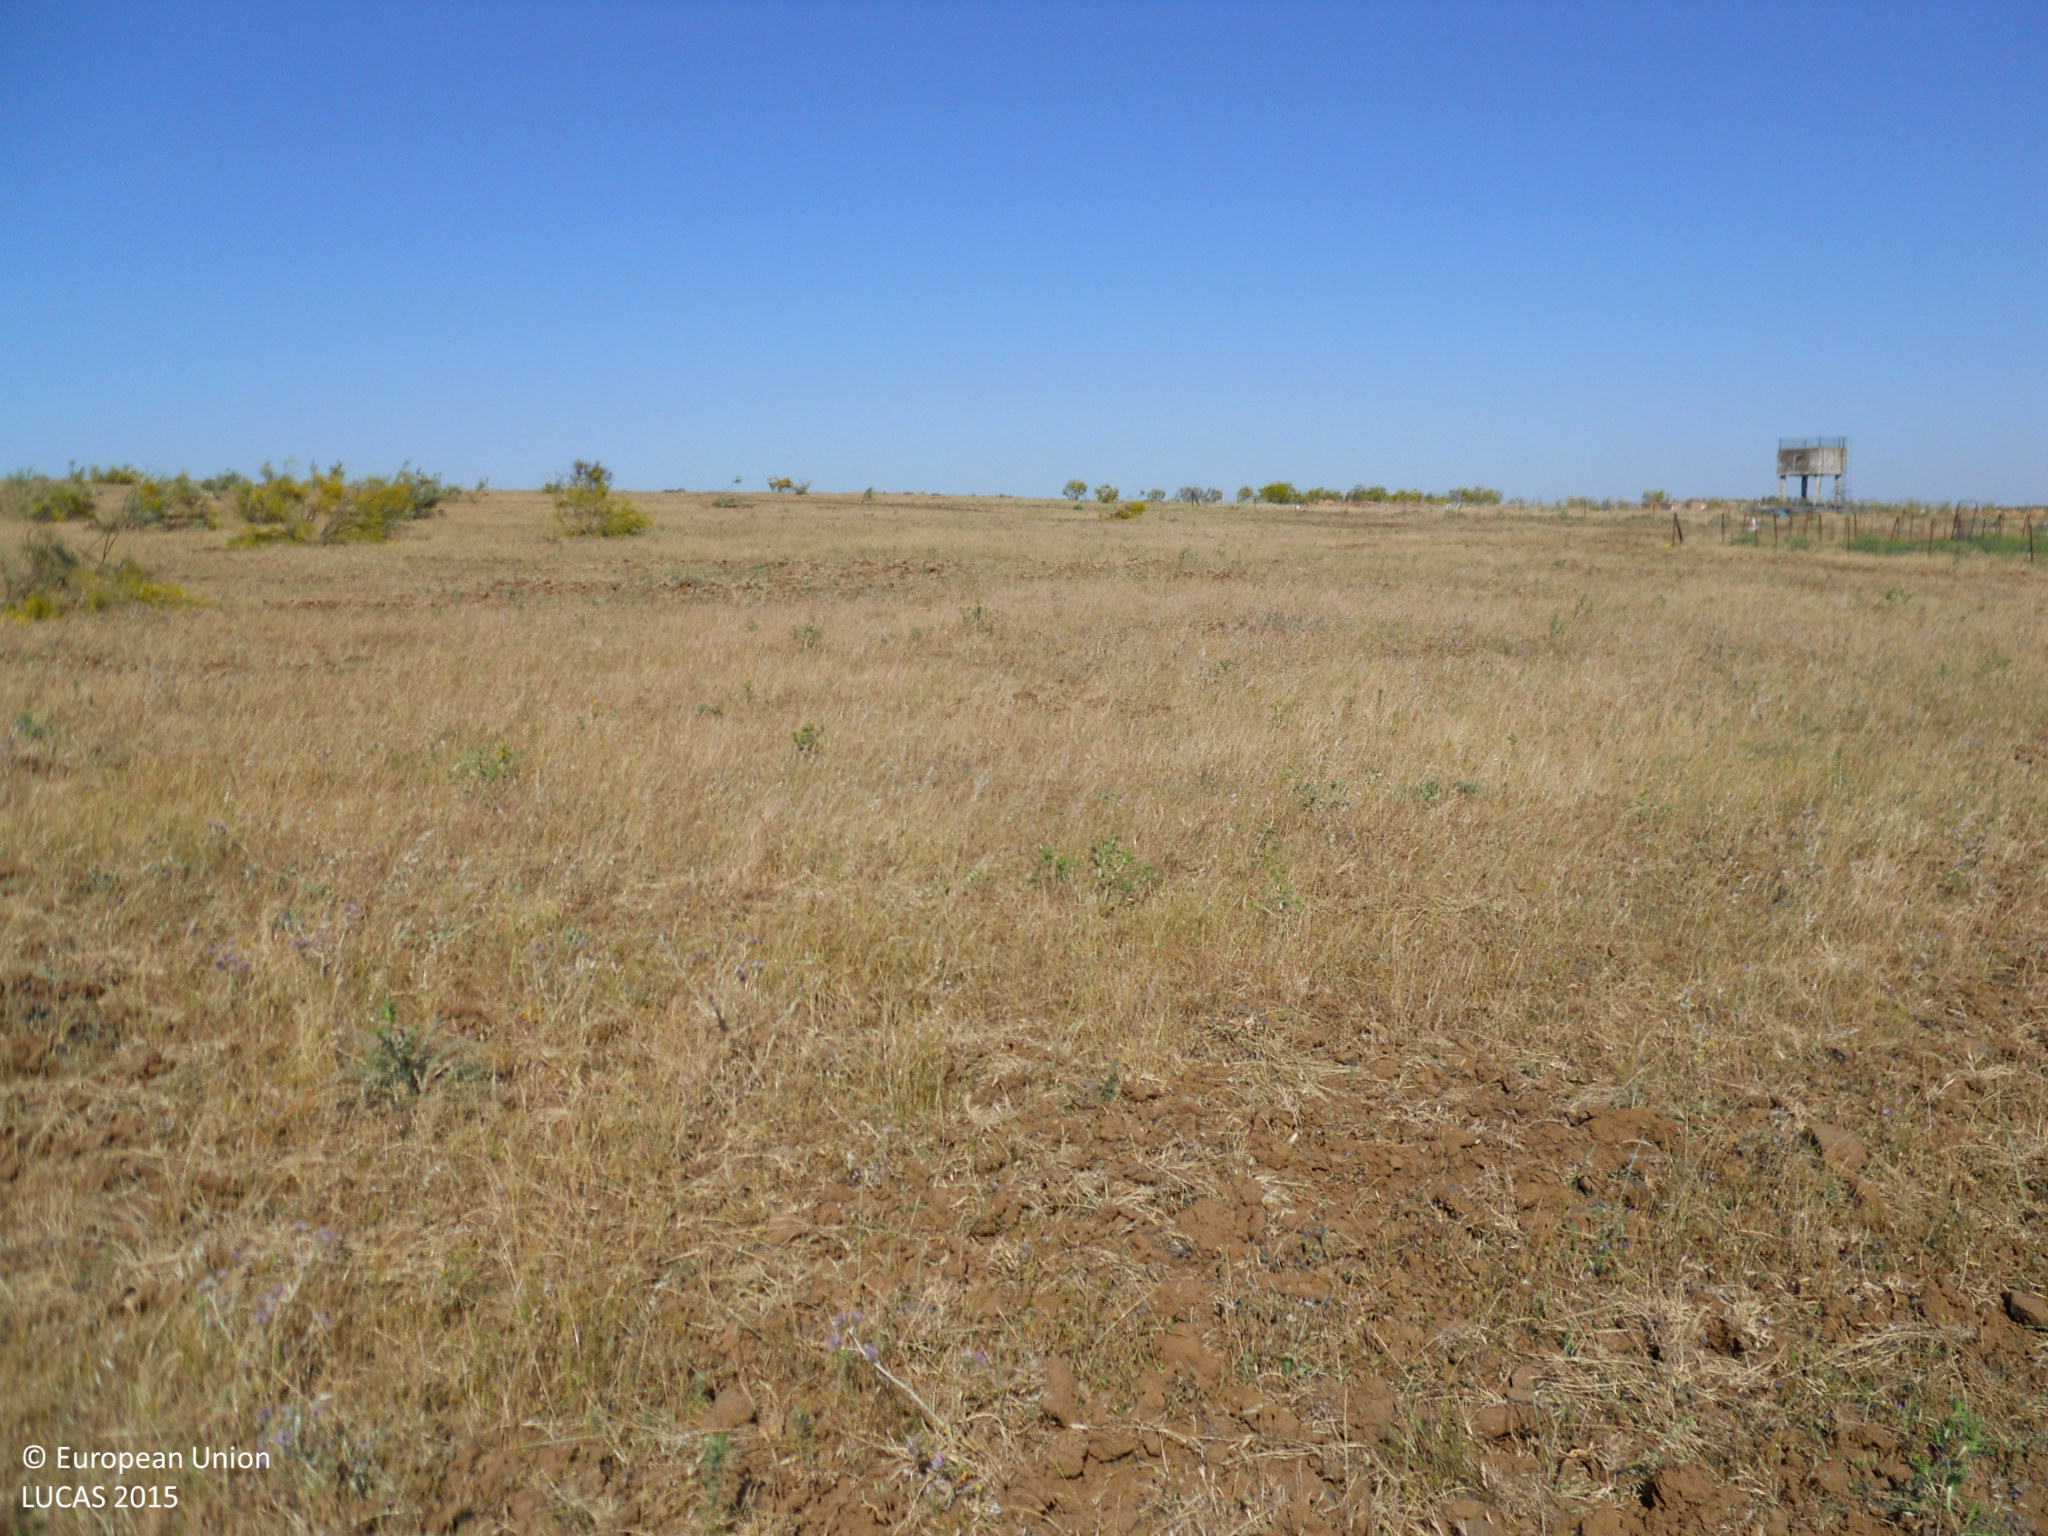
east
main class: Grassland
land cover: Grassland without tree/shrub cover
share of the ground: > 75 %
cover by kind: herbaceous plants 80 %, unconsolidated bare surface 20 %
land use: Agriculture (excluding fallow land and kitchen gardens)
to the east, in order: Grassland without tree/shrub cover; Fences; Grassland with sparse tree/shrub cover; Fences; Grassland without tree/shrub cover; Rock outcrops; Grassland without tree/shrub cover
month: May
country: ES
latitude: 38.9504
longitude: -6.2922
